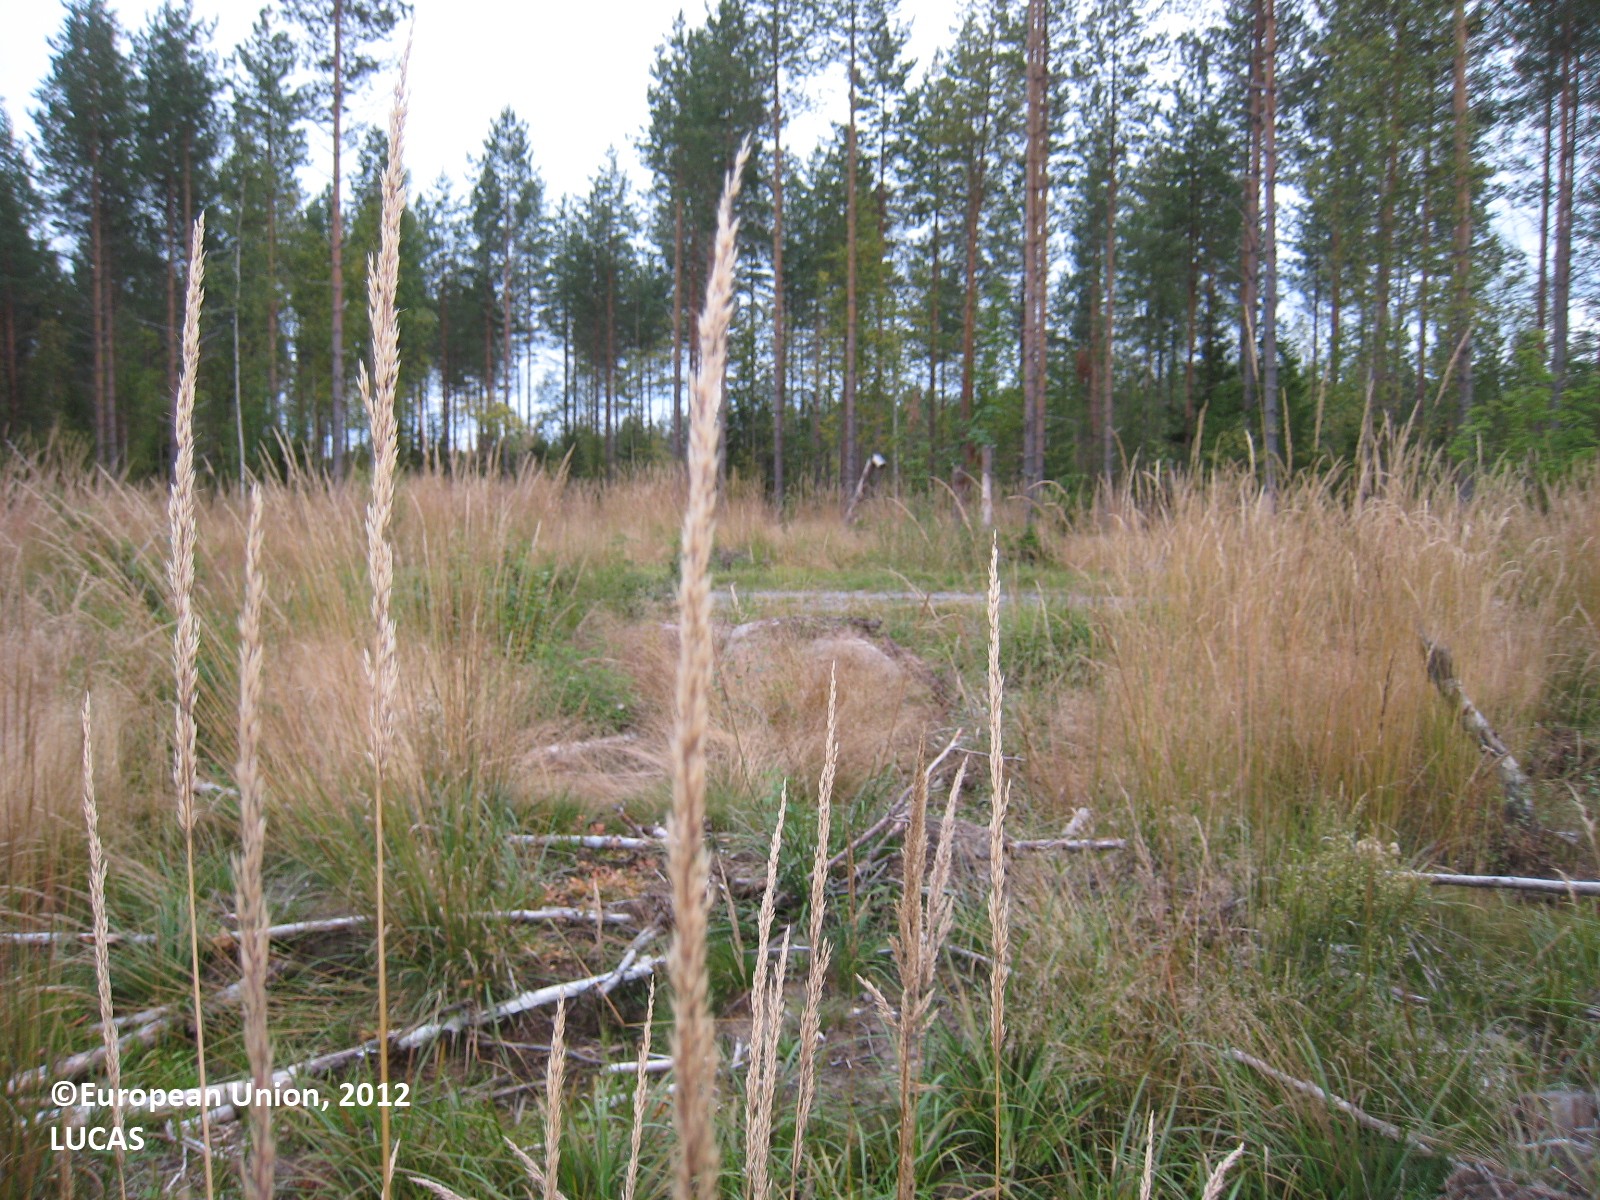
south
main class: Grassland
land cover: Grassland with sparse tree/shrub cover
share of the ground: > 75 %
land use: Forestry
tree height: < 5 m
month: August
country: FI
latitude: 62.3371
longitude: 27.3279
